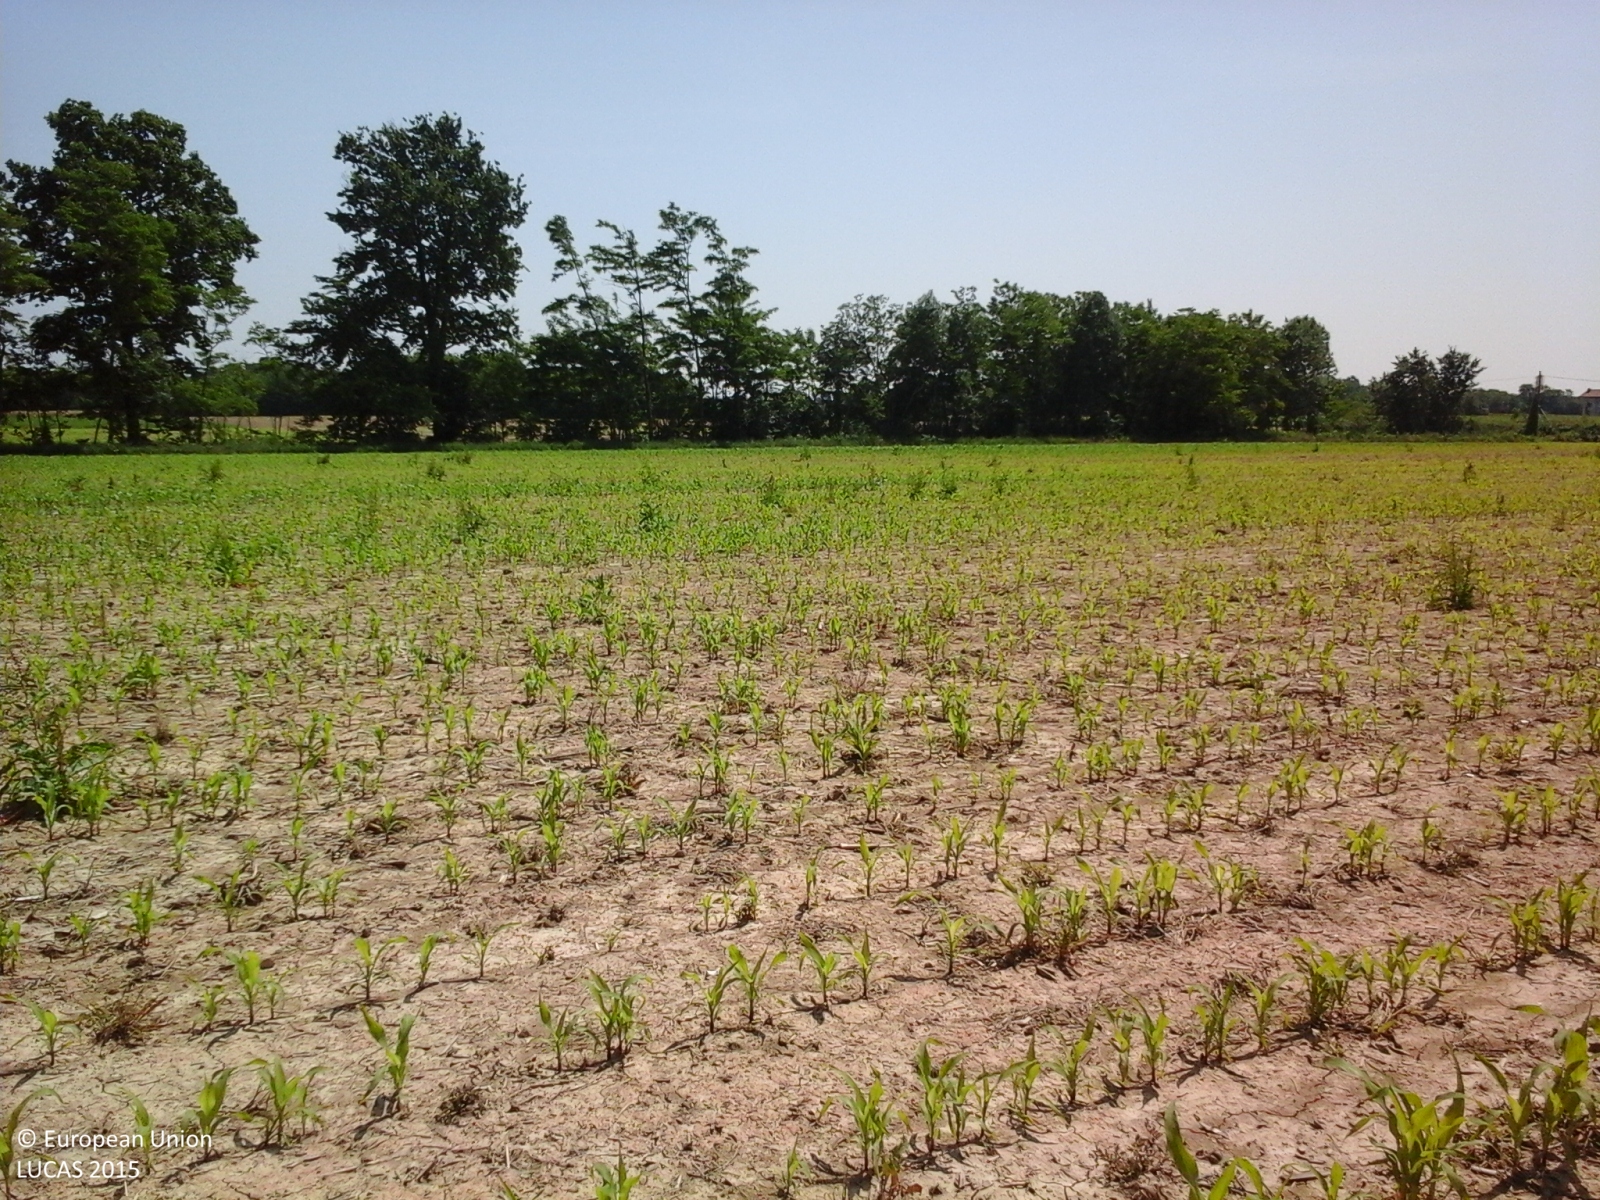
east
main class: Cropland
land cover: Maize
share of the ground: 10 - 25 %
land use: Agriculture (excluding fallow land and kitchen gardens)
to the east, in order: Maize; Managed hedges; Ditches and canals; Managed hedges; Maize; Ditches and canals; Tracks; Spontaneously vegetated surfaces
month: May
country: IT
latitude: 45.5053
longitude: 8.0960
